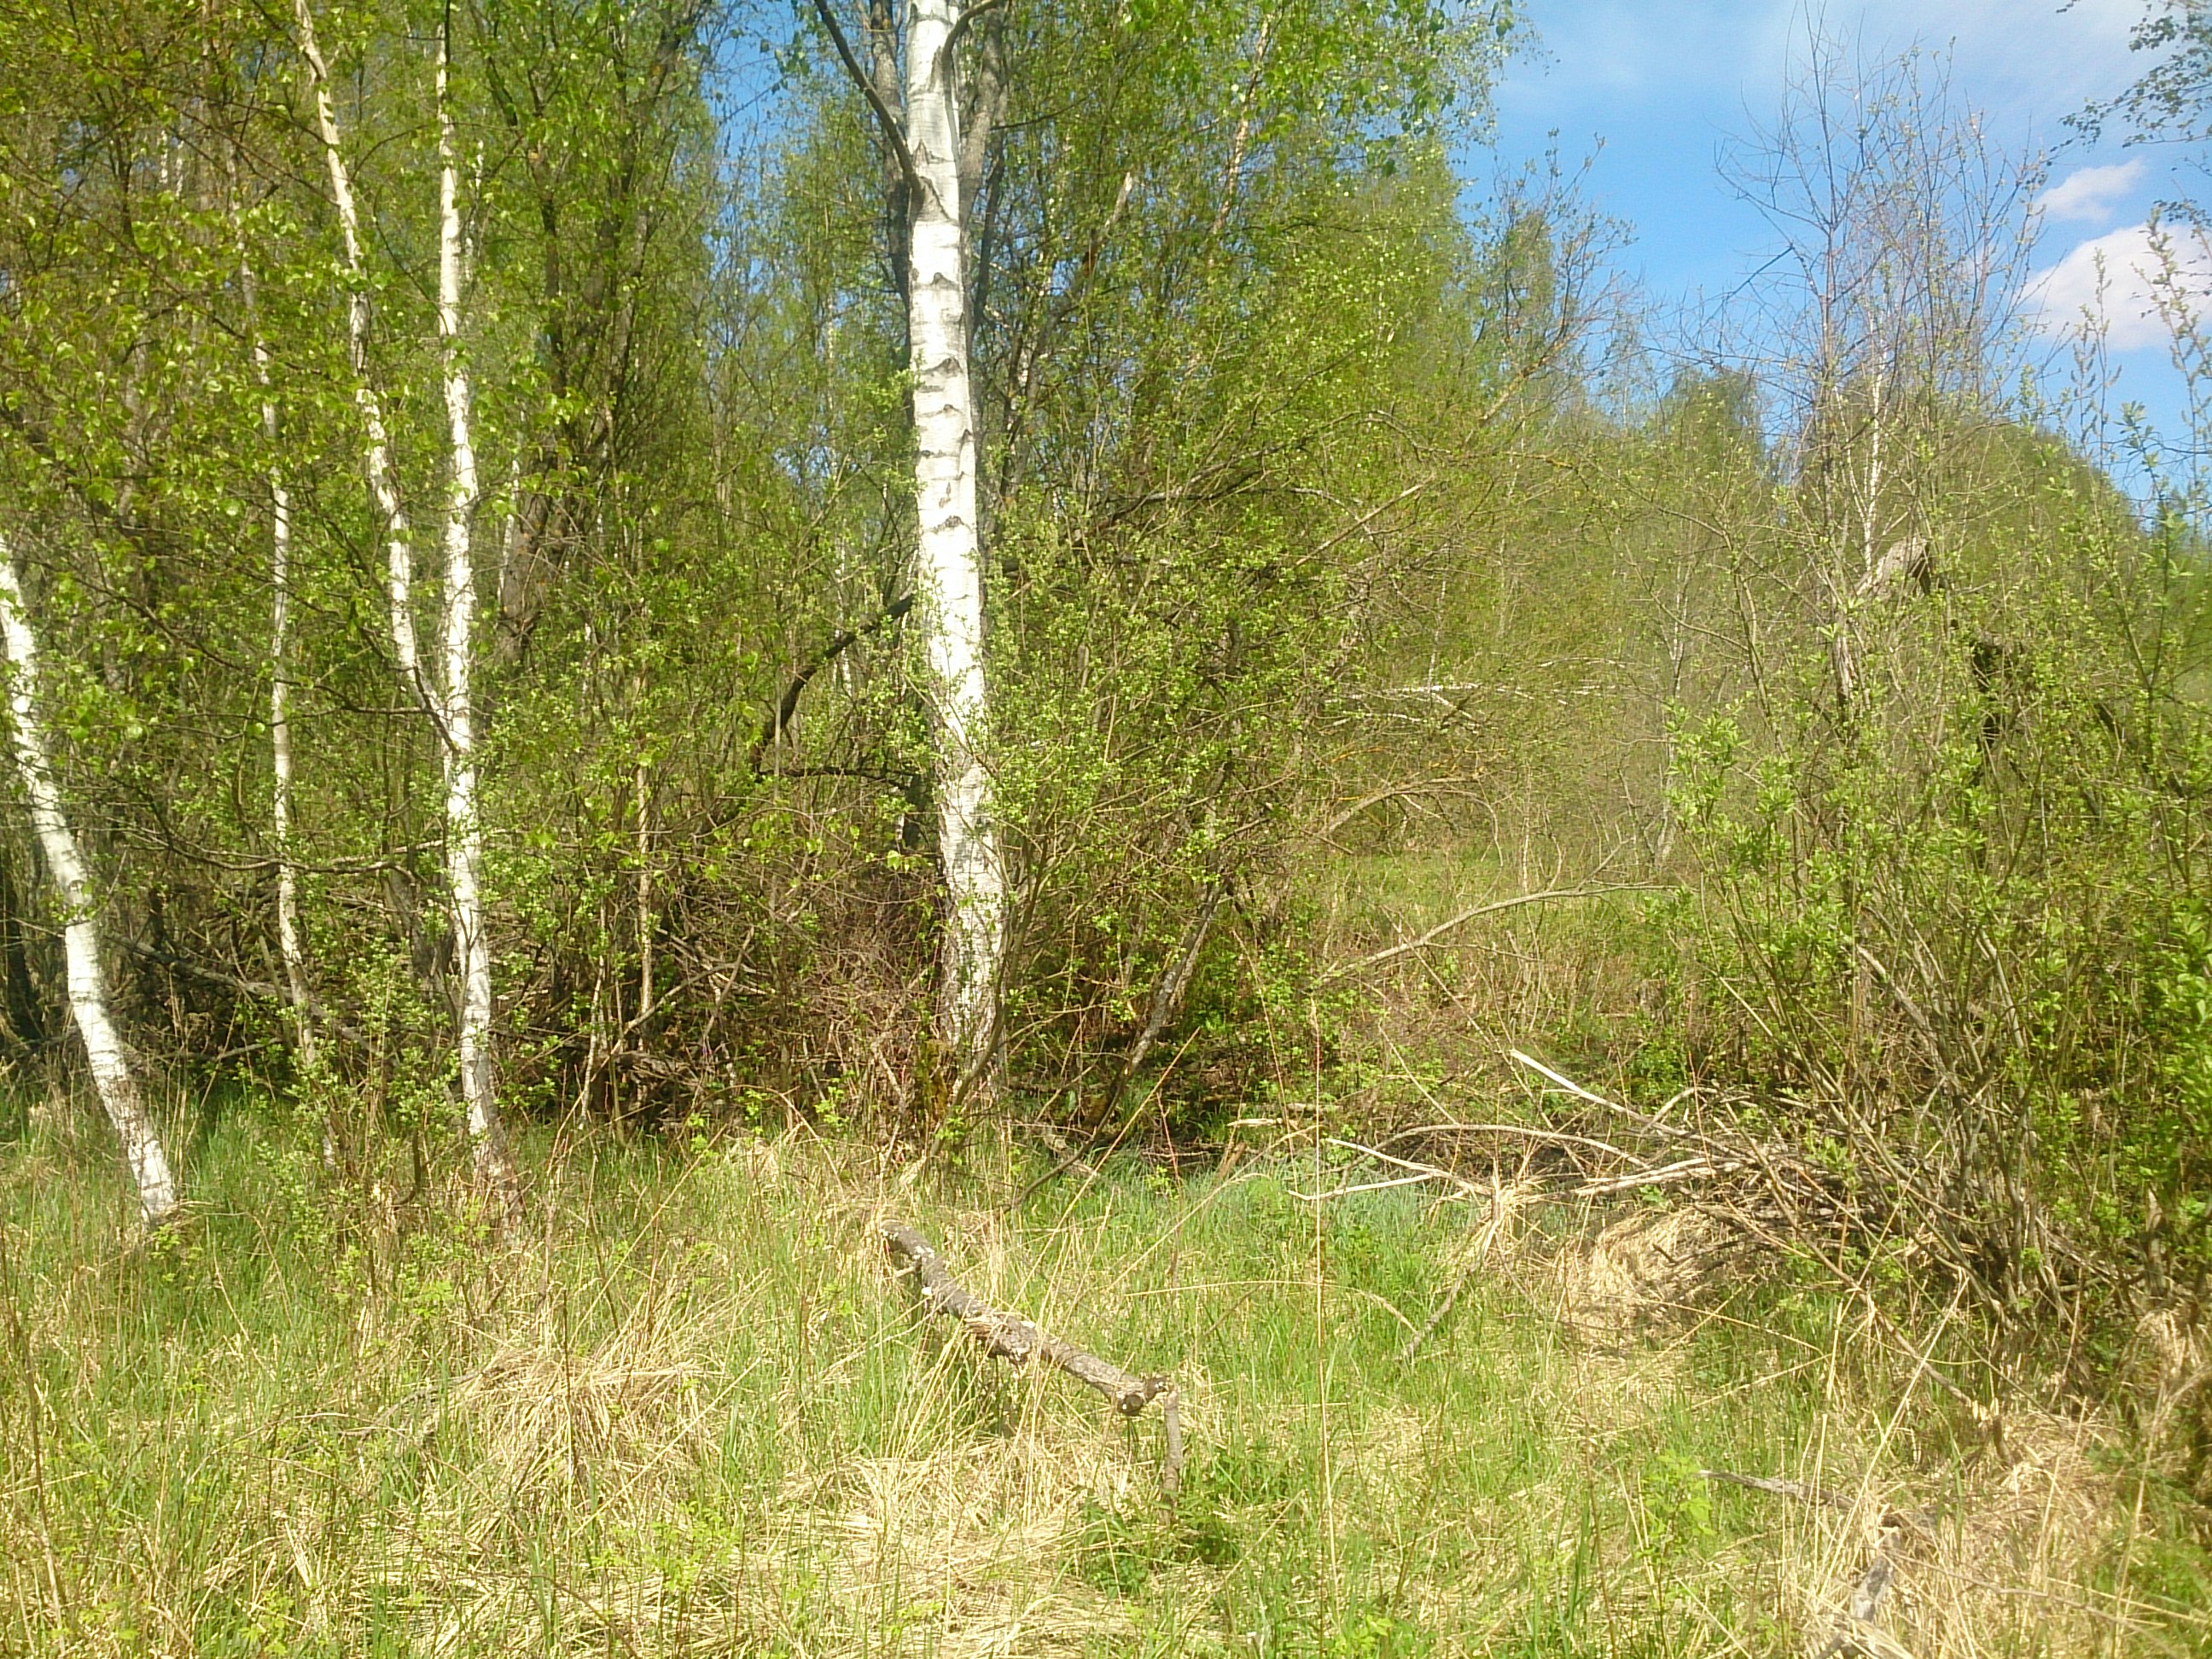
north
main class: Shrubland
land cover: Shrubland without tree cover
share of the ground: > 75 %
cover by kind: shrubs 70 %, herbaceous plants 30 %
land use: Semi-natural and natural areas not in use
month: May
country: LV
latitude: 56.6722
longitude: 24.3718
